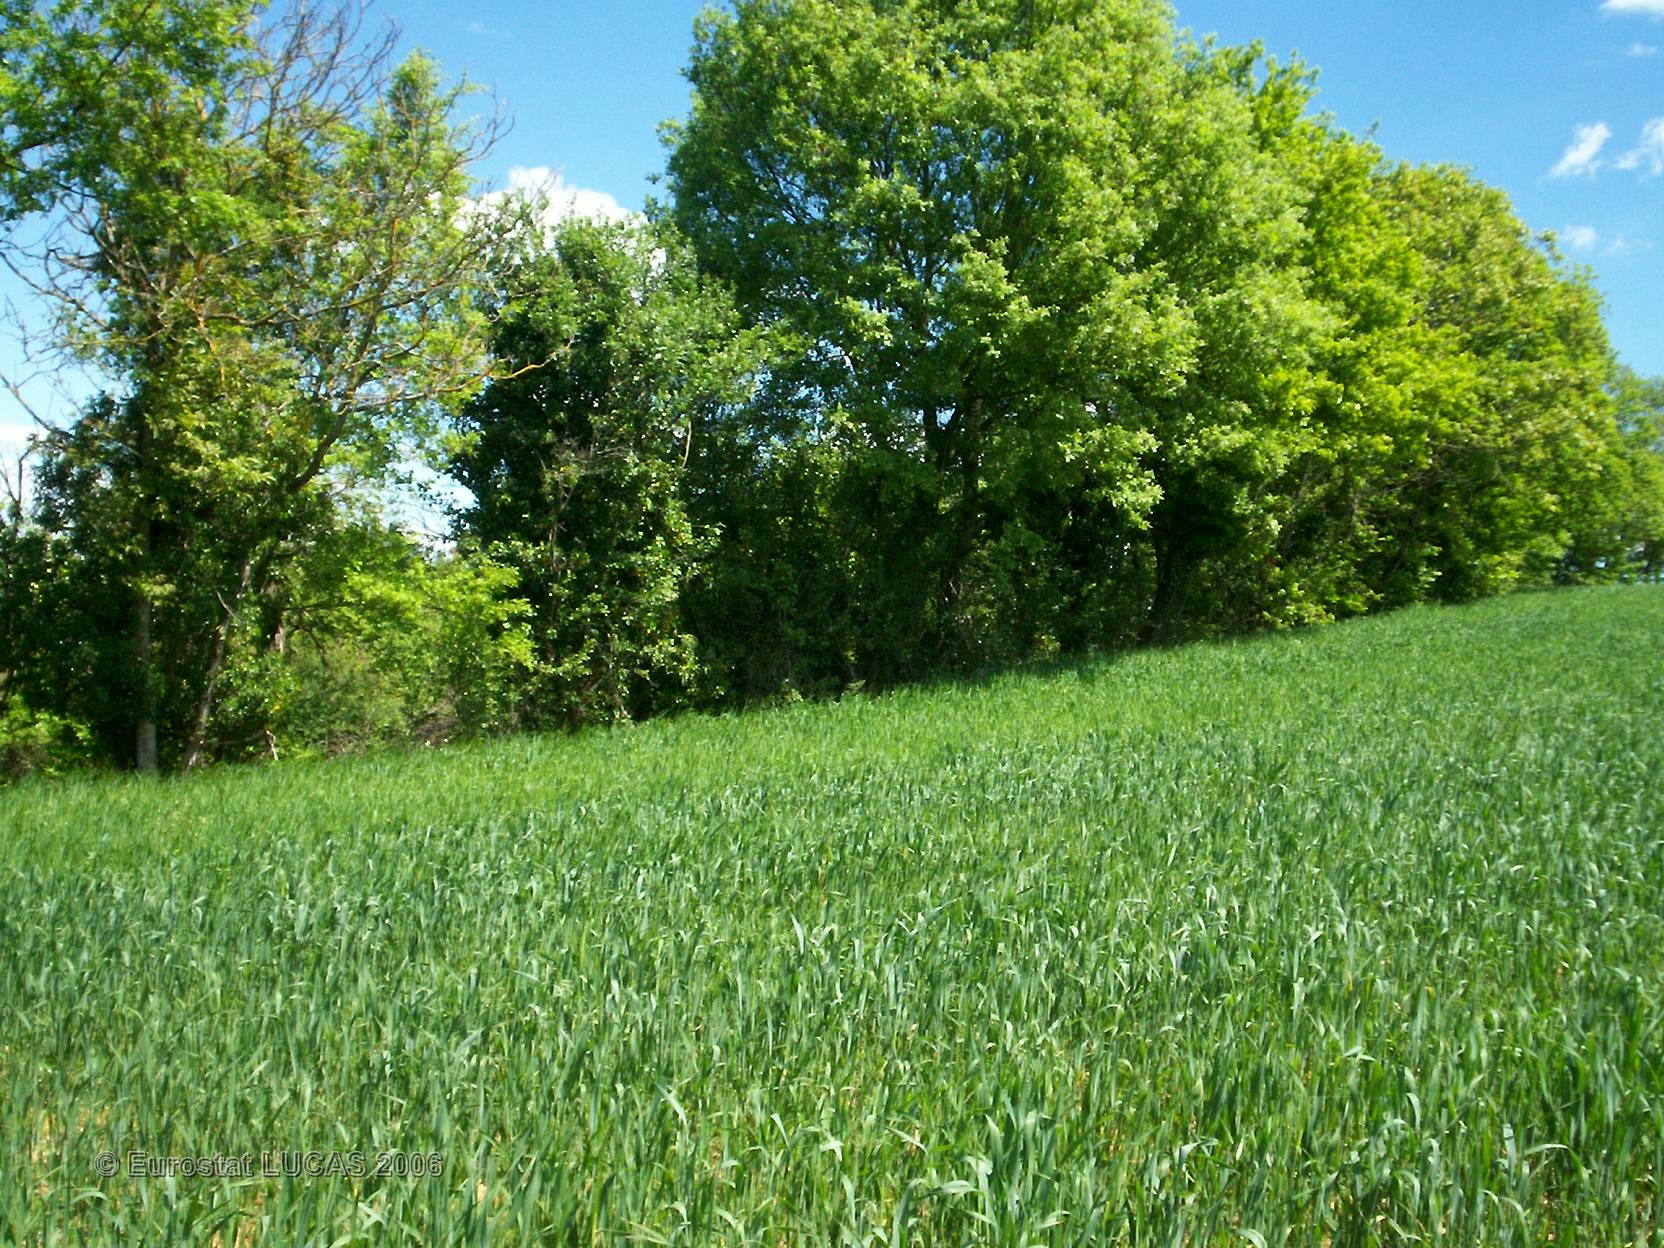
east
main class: Cropland
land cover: Barley
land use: Agriculture (excluding fallow land and kitchen gardens)
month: May
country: FR
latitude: 44.1651
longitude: 1.9609
